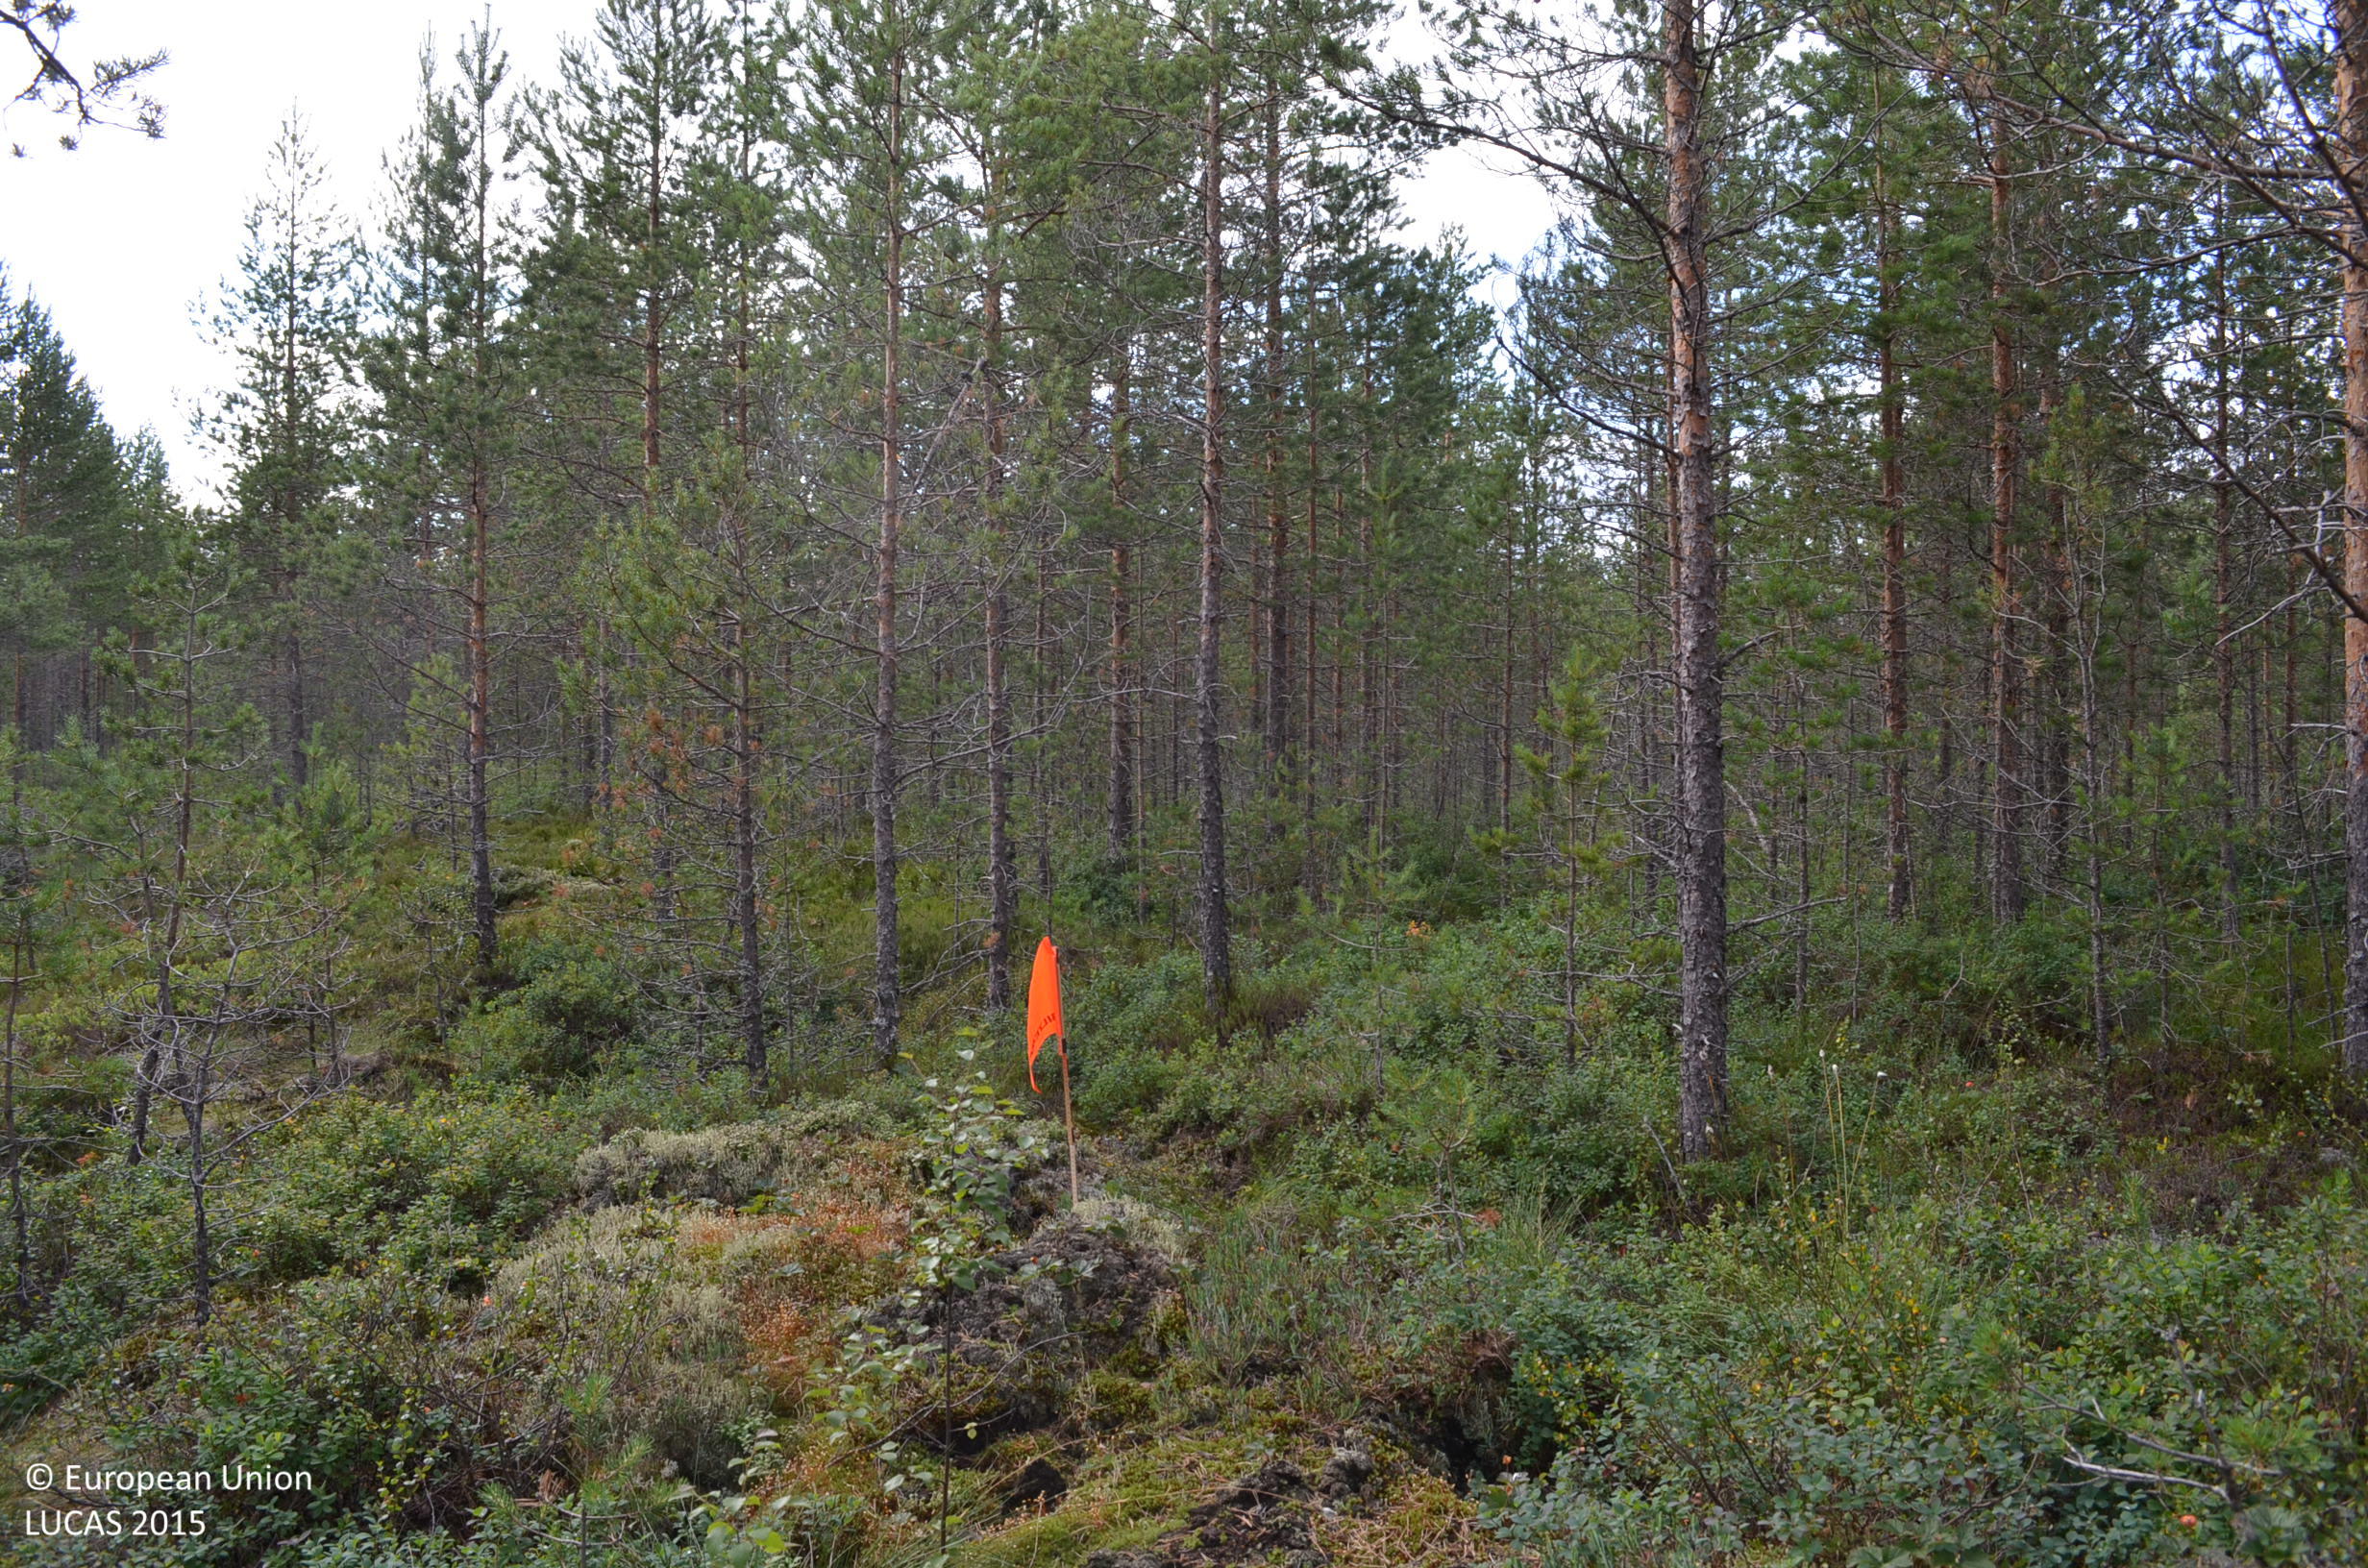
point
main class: Woodland
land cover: Pine dominated coniferous woodland
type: boreal forest
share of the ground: > 75 %
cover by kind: coniferous forest trees 75 %, shrubs 25 %
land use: Forestry
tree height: < 5 m
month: July
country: FI
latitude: 62.1943
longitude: 23.3887
